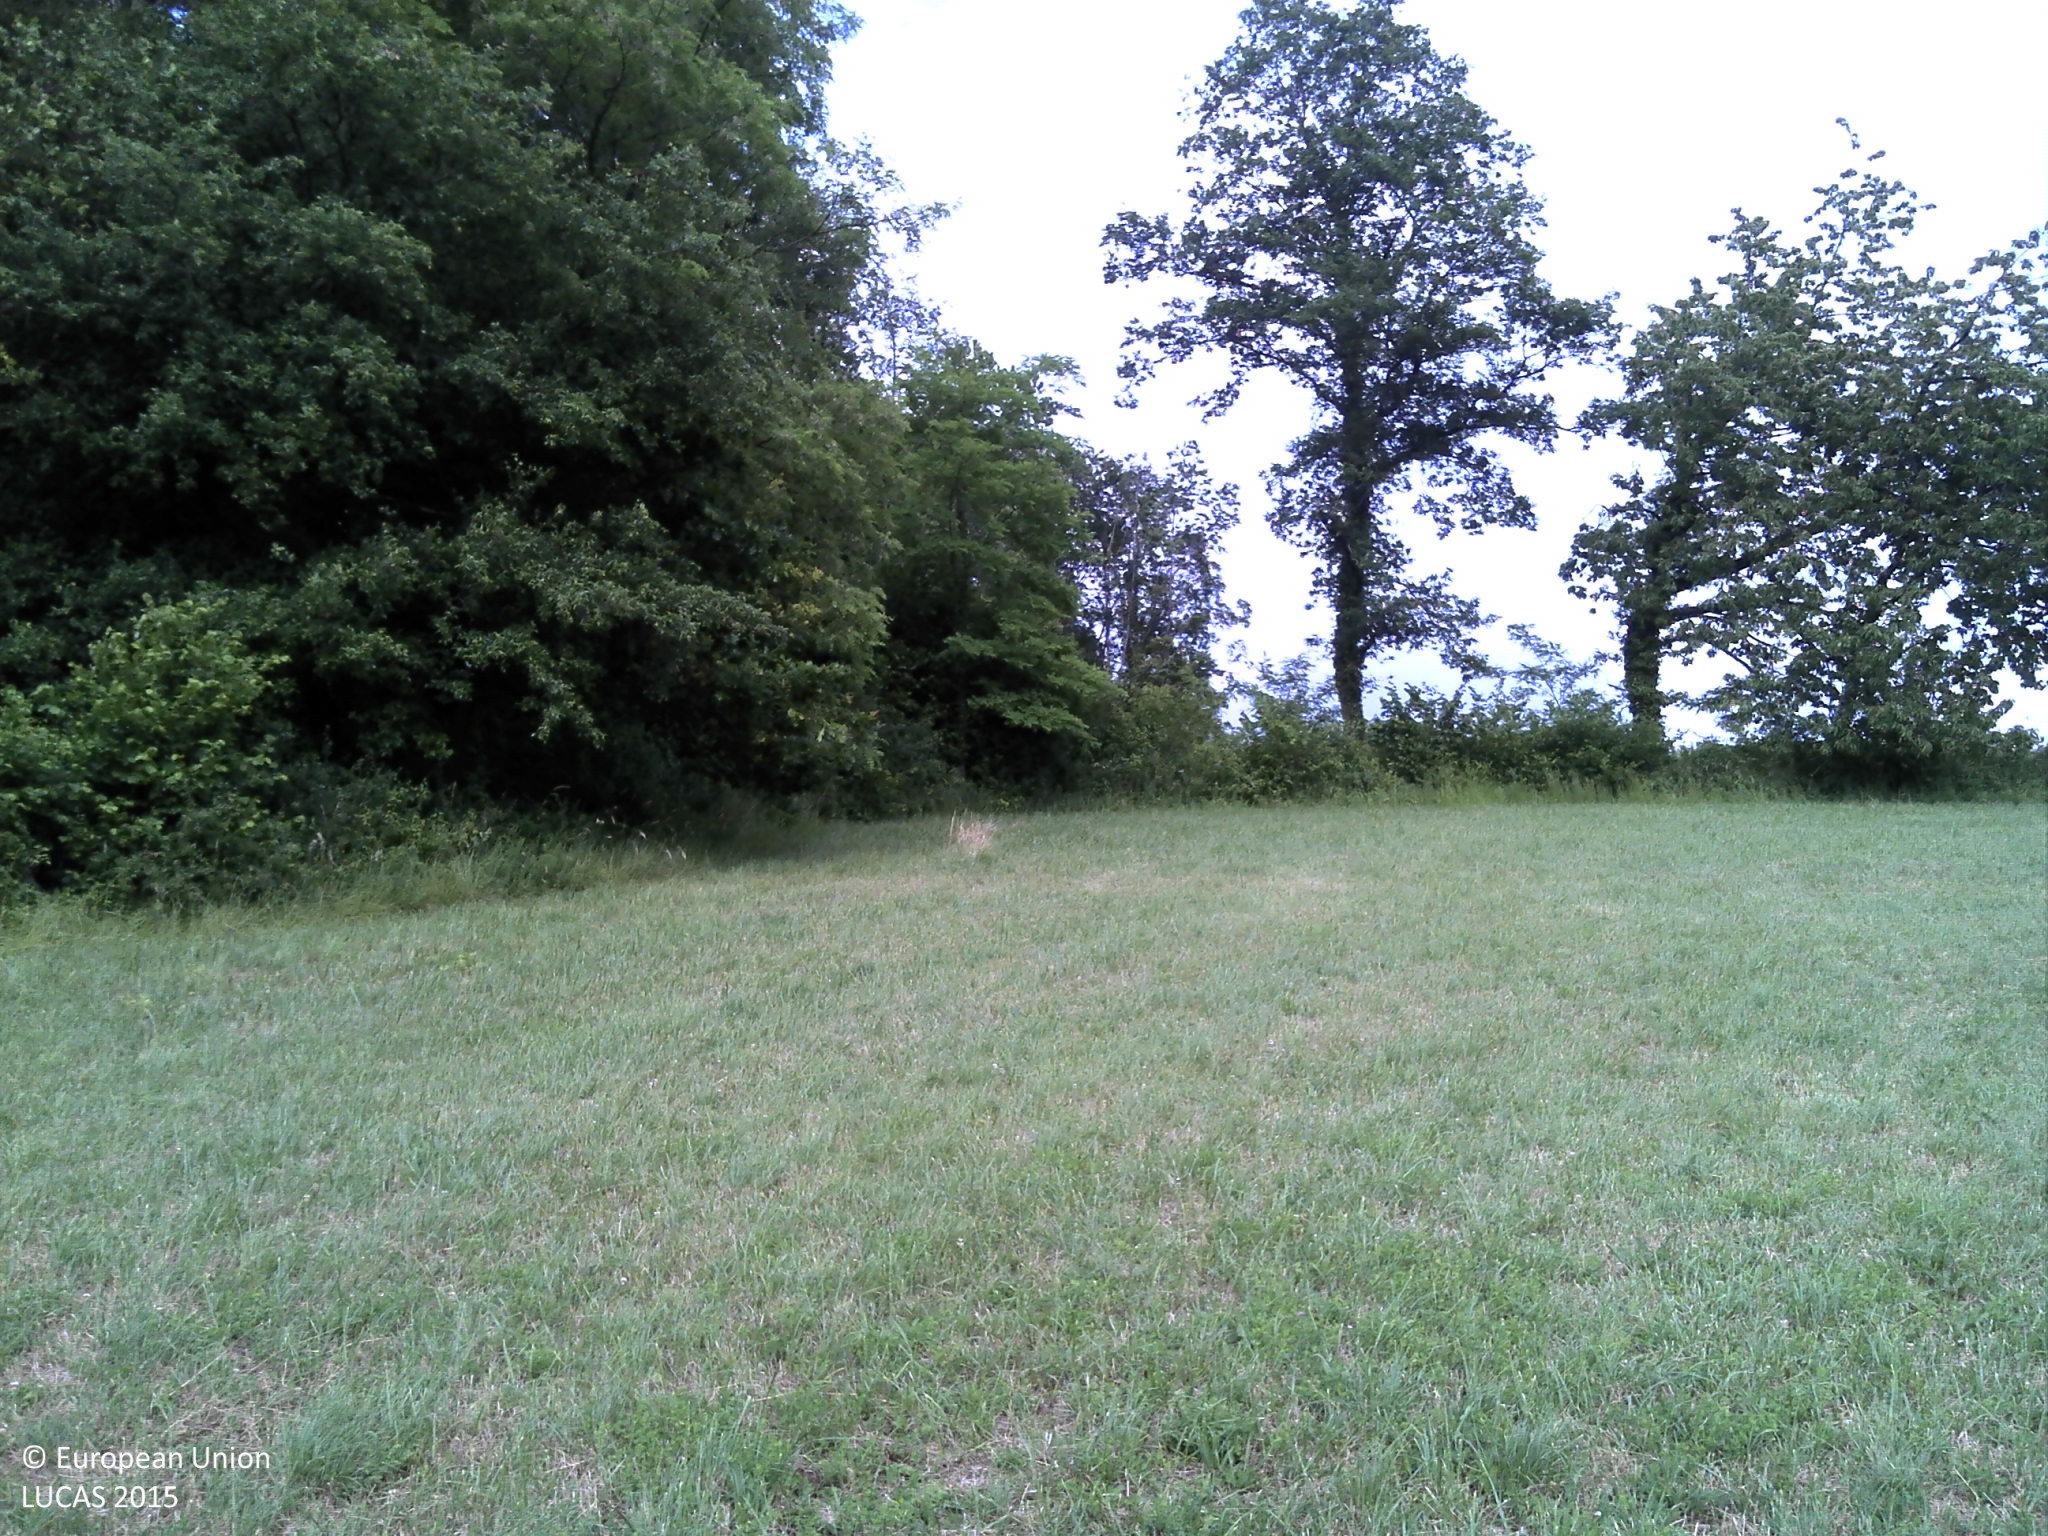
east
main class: Grassland
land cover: Grassland without tree/shrub cover
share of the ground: > 75 %
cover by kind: herbaceous plants 100 %
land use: Agriculture (excluding fallow land and kitchen gardens)
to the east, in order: Grassland without tree/shrub cover; Broadleaved woodland; Common wheat
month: June
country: FR
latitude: 49.4472
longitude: 5.0736
